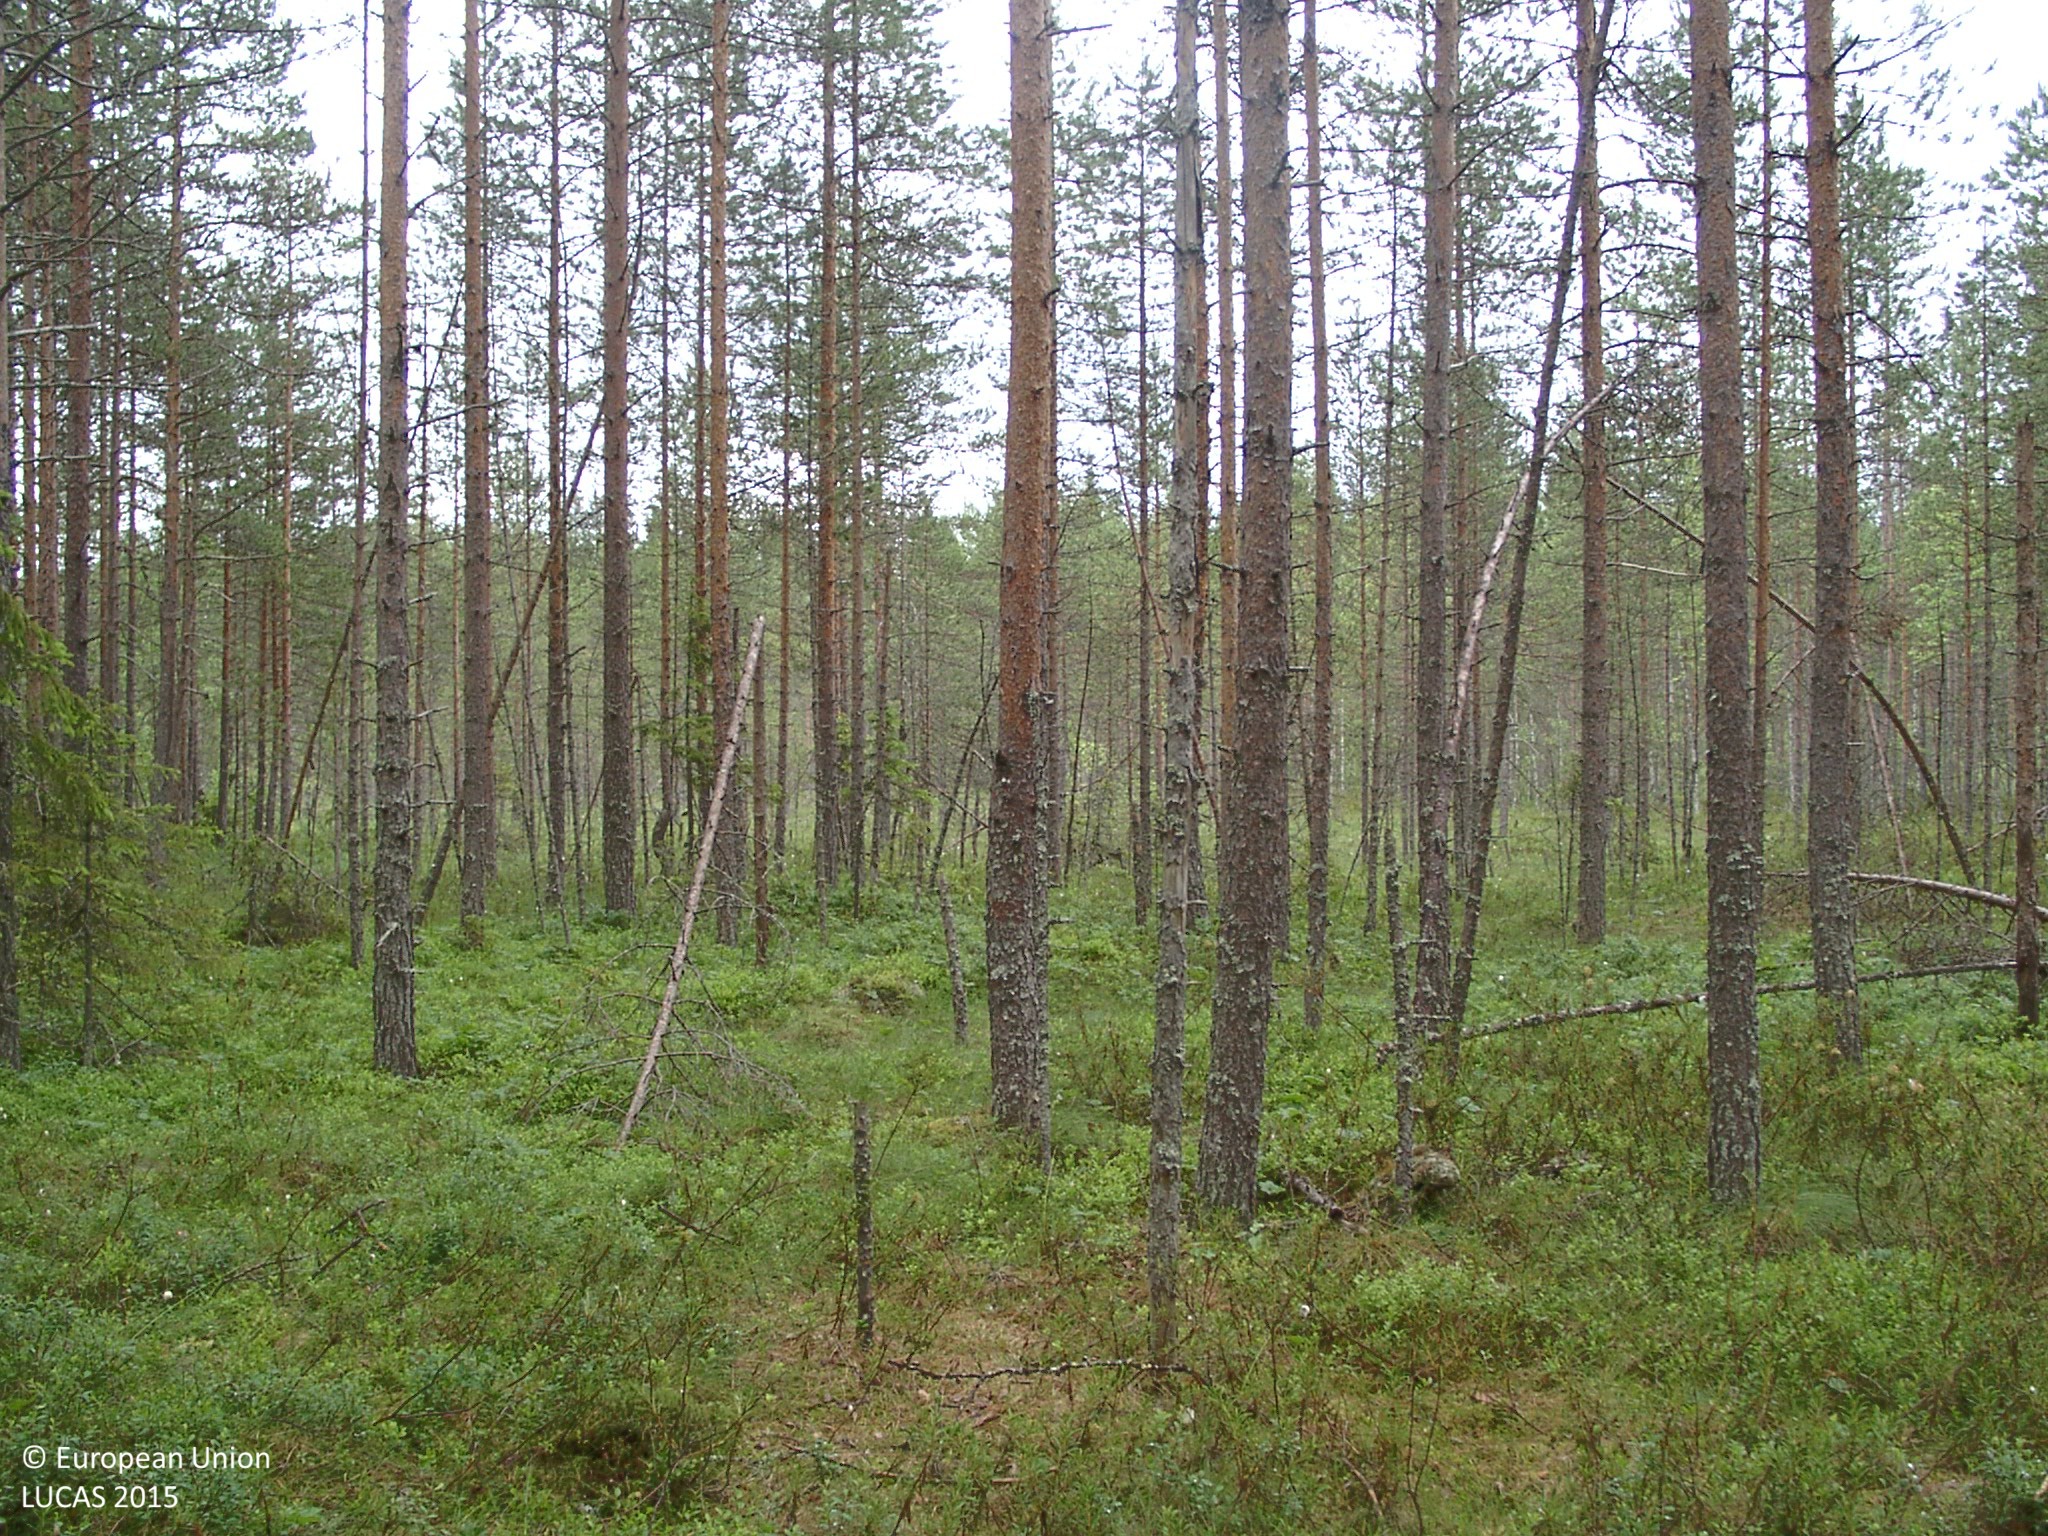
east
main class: Woodland
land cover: Other mixed woodland
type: boreal forest
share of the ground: > 75 %
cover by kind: coniferous forest trees 50 %, broadleaved forest trees 25 %, shrubs 10 %, lichens and mosses 10 %, herbaceous plants 5 %
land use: Semi-natural and natural areas not in use
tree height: > 5 m
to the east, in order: Pine dominated coniferous woodland; Ditches and canals; Pine dominated coniferous woodland; Ditches and canals; Pine dominated mixed woodland; Ditches and canals; Other coniferous woodland; Other mixed woodland; Spruce dominated mixed woodland
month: July
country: FI
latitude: 62.1484
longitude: 25.3658
